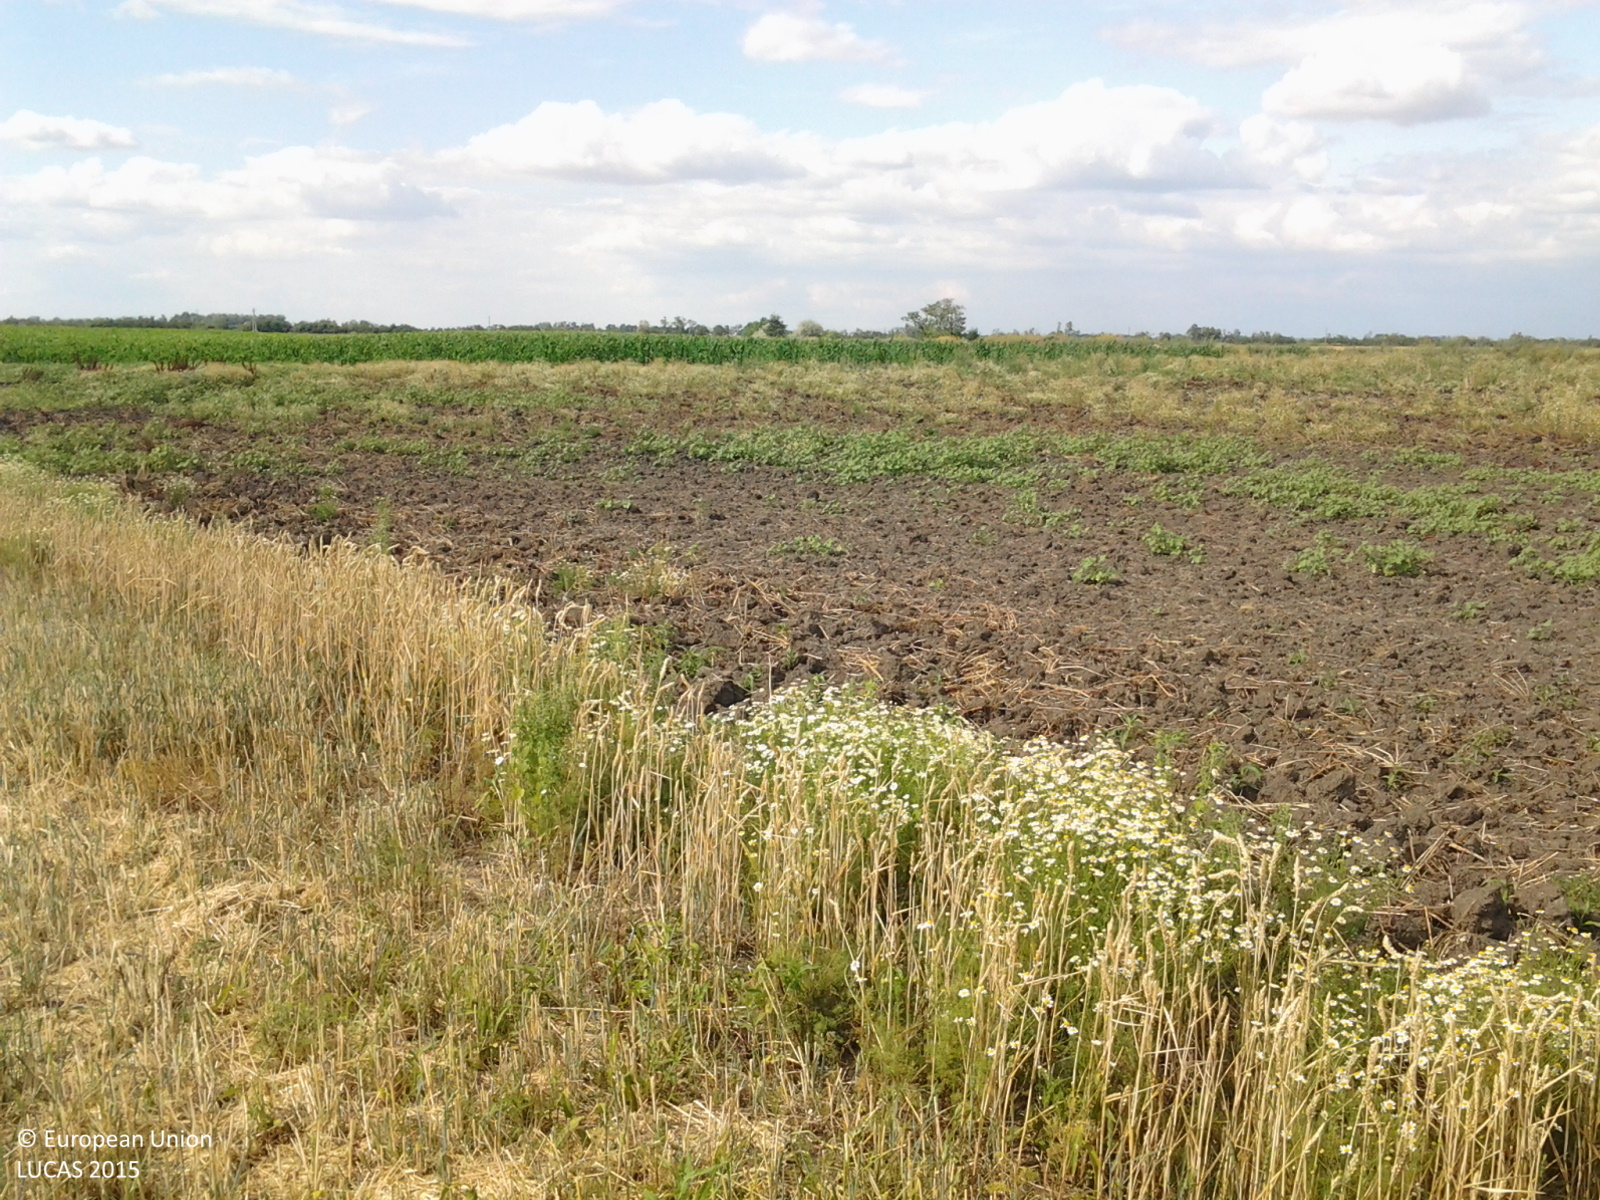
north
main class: Cropland
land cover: Common wheat
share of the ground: 25 - 50 %
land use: Agriculture (excluding fallow land and kitchen gardens)
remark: Harvested field
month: July
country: HU
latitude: 47.2964
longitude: 20.3836
